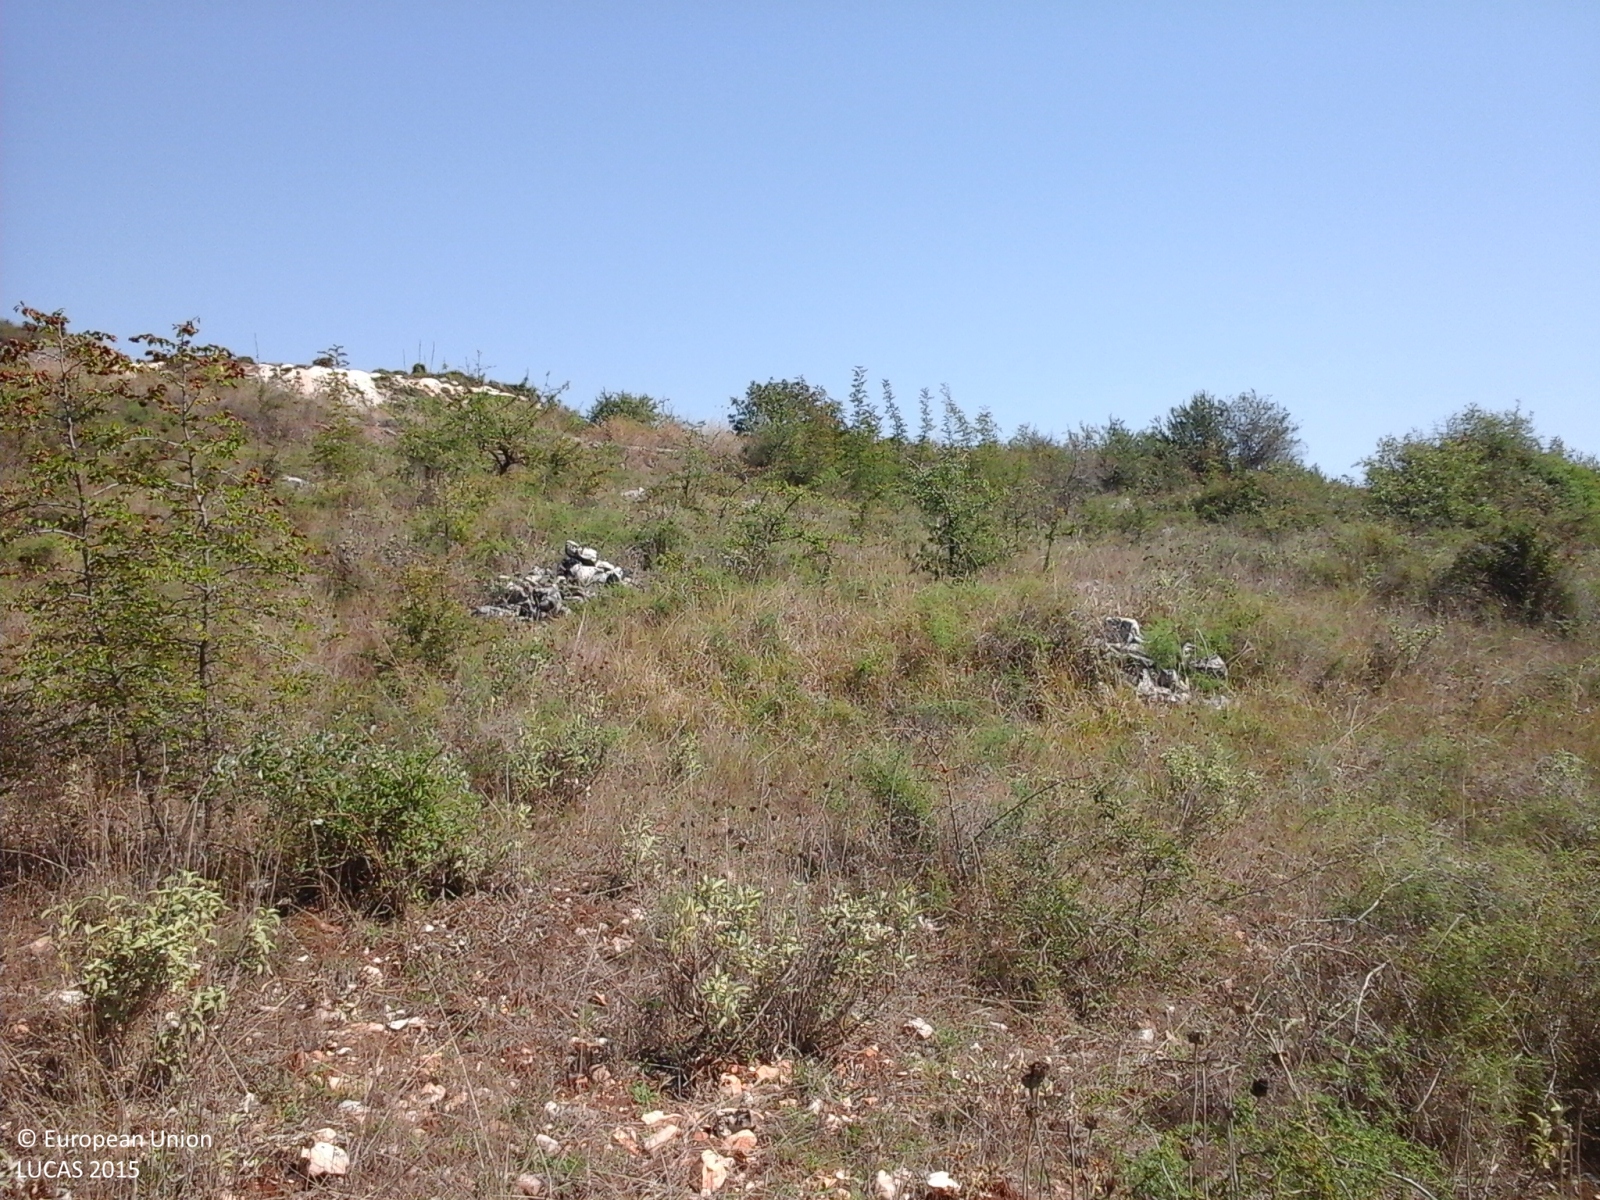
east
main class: Grassland
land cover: Grassland with sparse tree/shrub cover
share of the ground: > 75 %
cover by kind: herbaceous plants 70 %, unconsolidated bare surface 15 %, shrubs 10 %, broadleaved forest trees 5 %
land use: Semi-natural and natural areas not in use
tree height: < 5 m
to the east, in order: Grassland with sparse tree/shrub cover; Paved roads, cycling and walking lanes; Grassland with sparse tree/shrub cover; Shrubland without tree cover
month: September
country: GR
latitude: 39.7196
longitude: 20.6755
